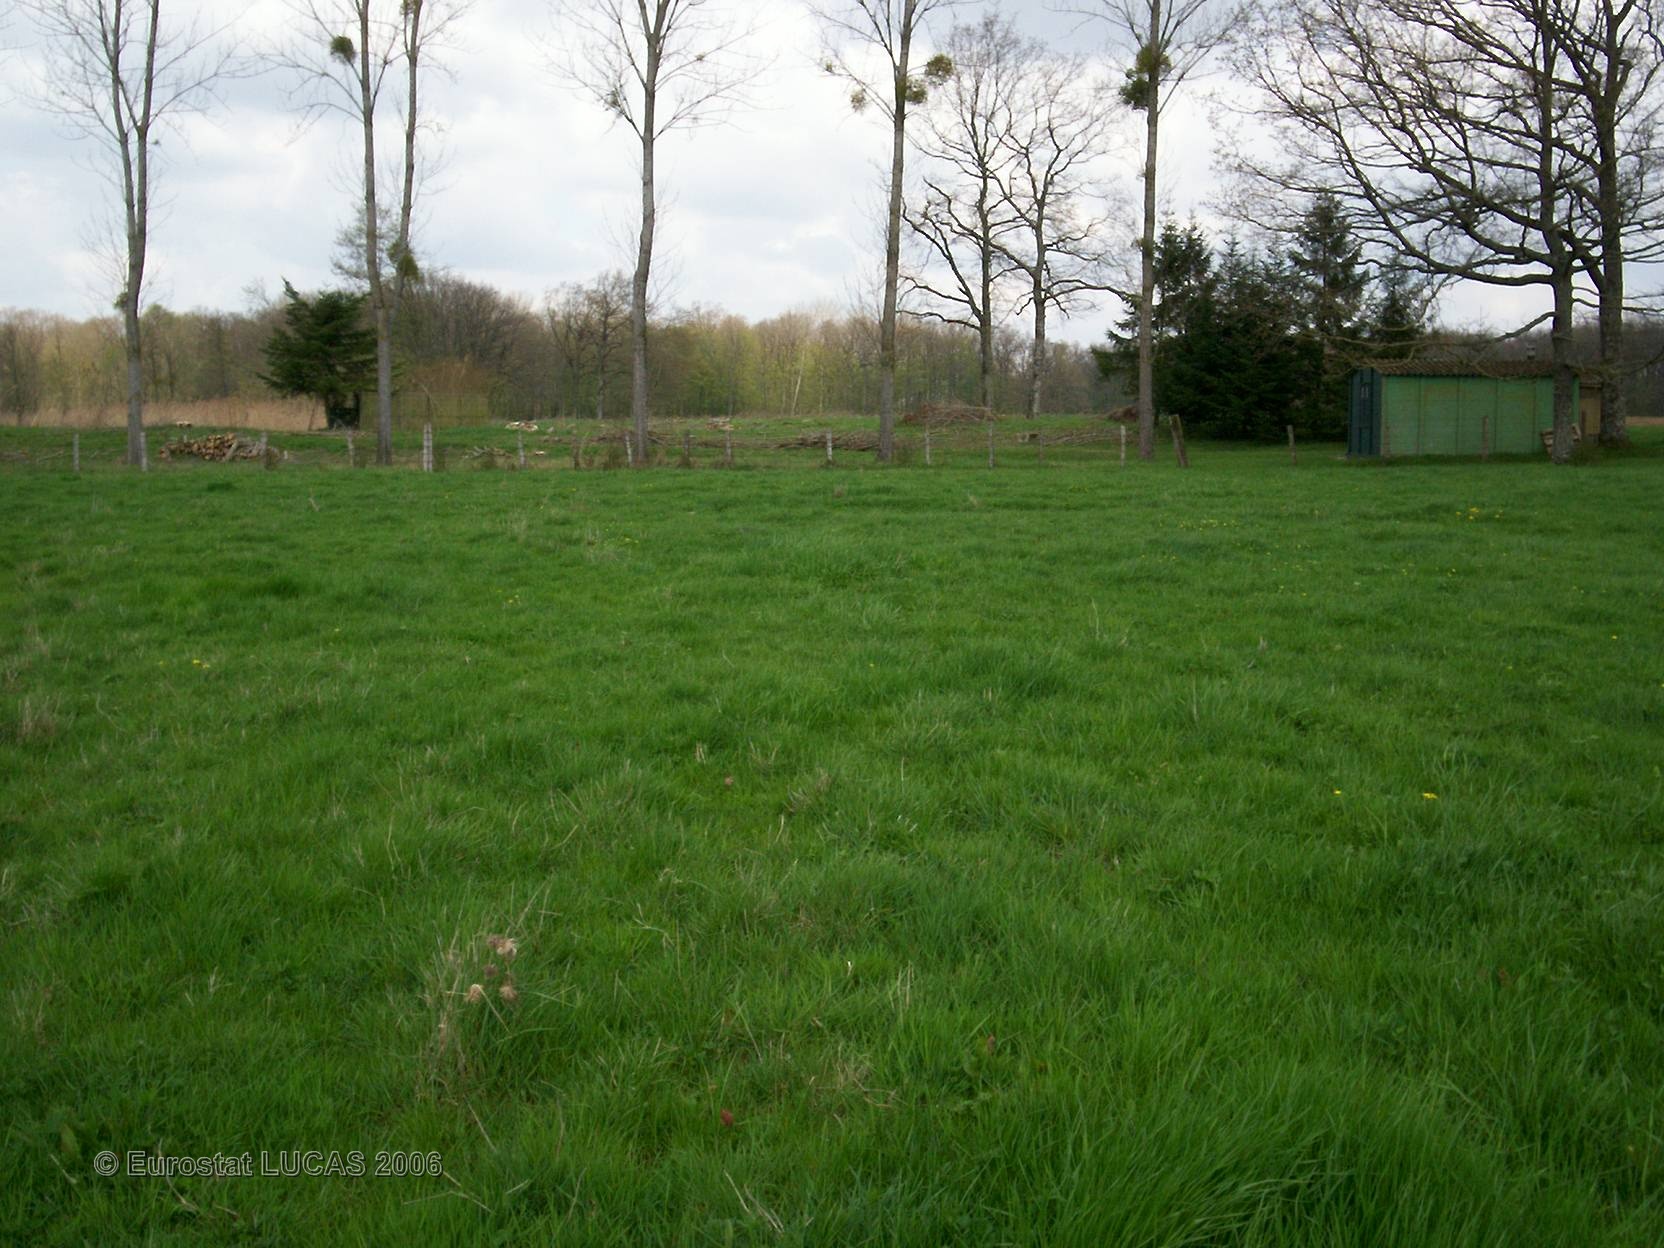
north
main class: Grassland
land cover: Grassland without tree/shrub cover
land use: Agriculture (excluding fallow land and kitchen gardens)
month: April
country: FR
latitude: 48.5264
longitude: 4.6490
